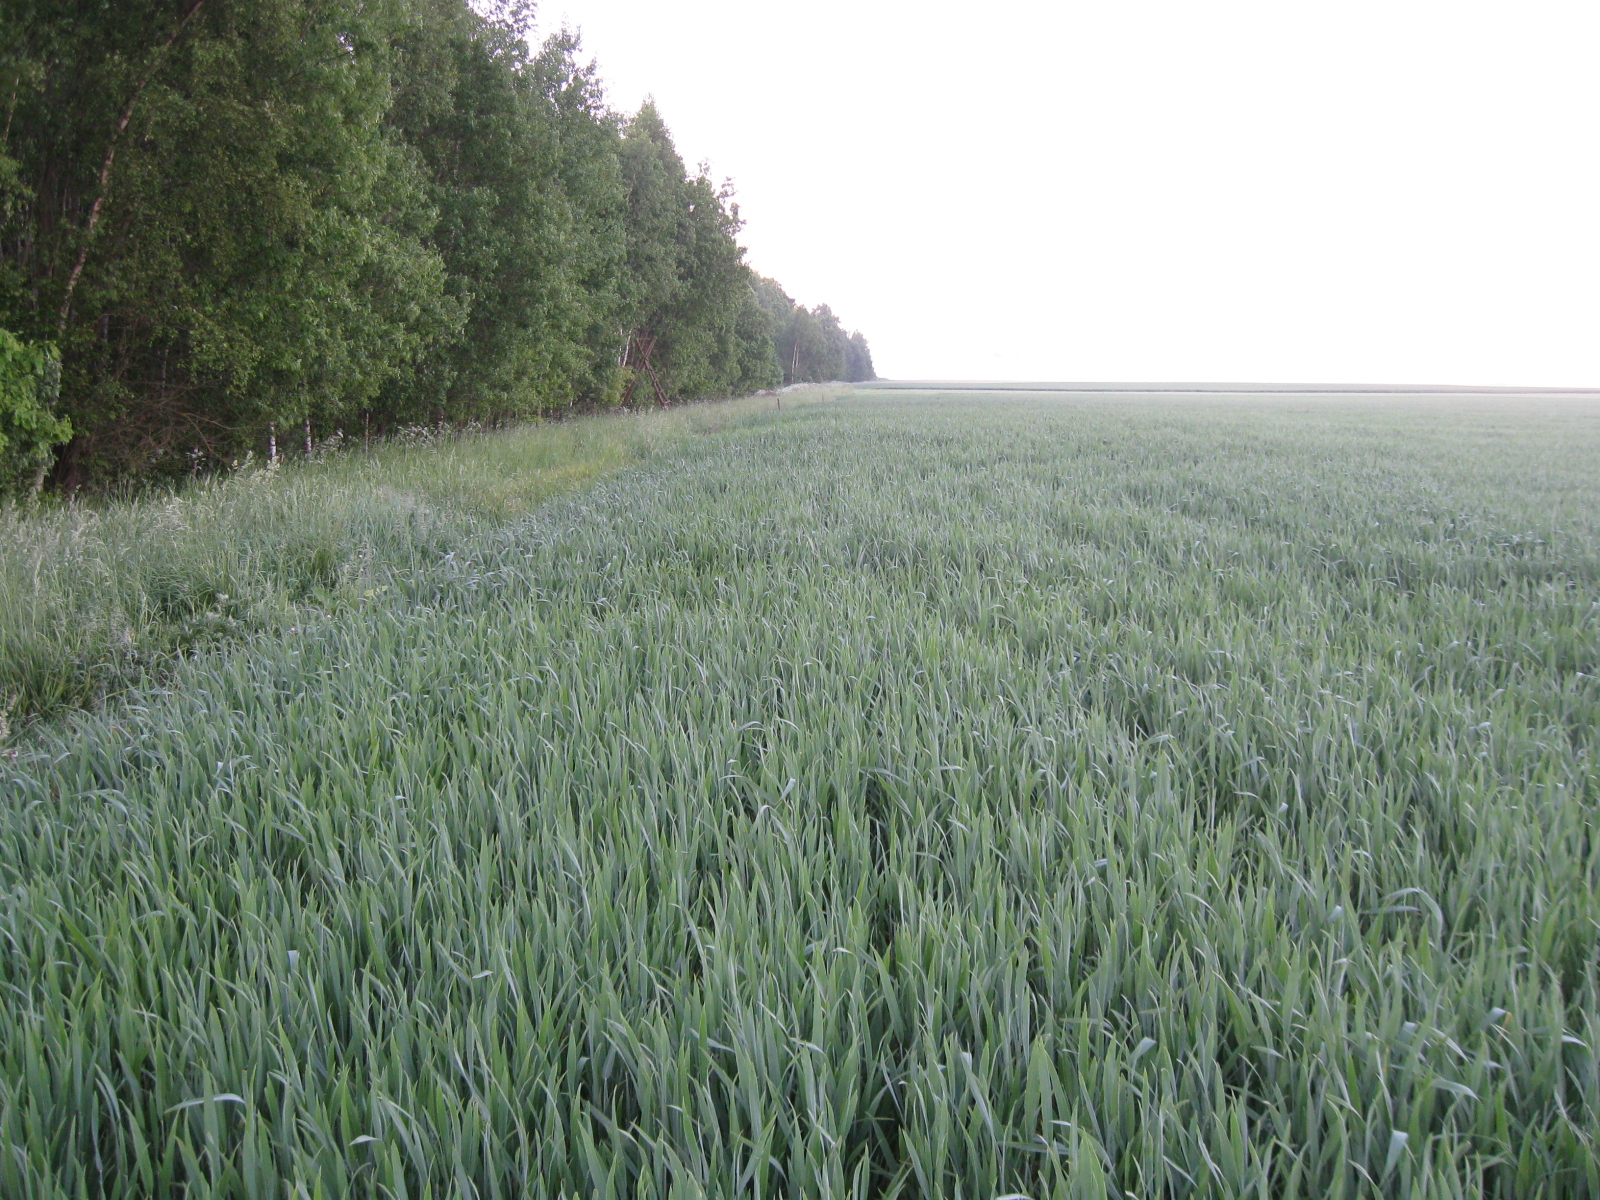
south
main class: Cropland
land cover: Common wheat
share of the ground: > 75 %
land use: Agriculture (excluding fallow land and kitchen gardens)
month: June
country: LT
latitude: 54.4685
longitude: 23.8049
